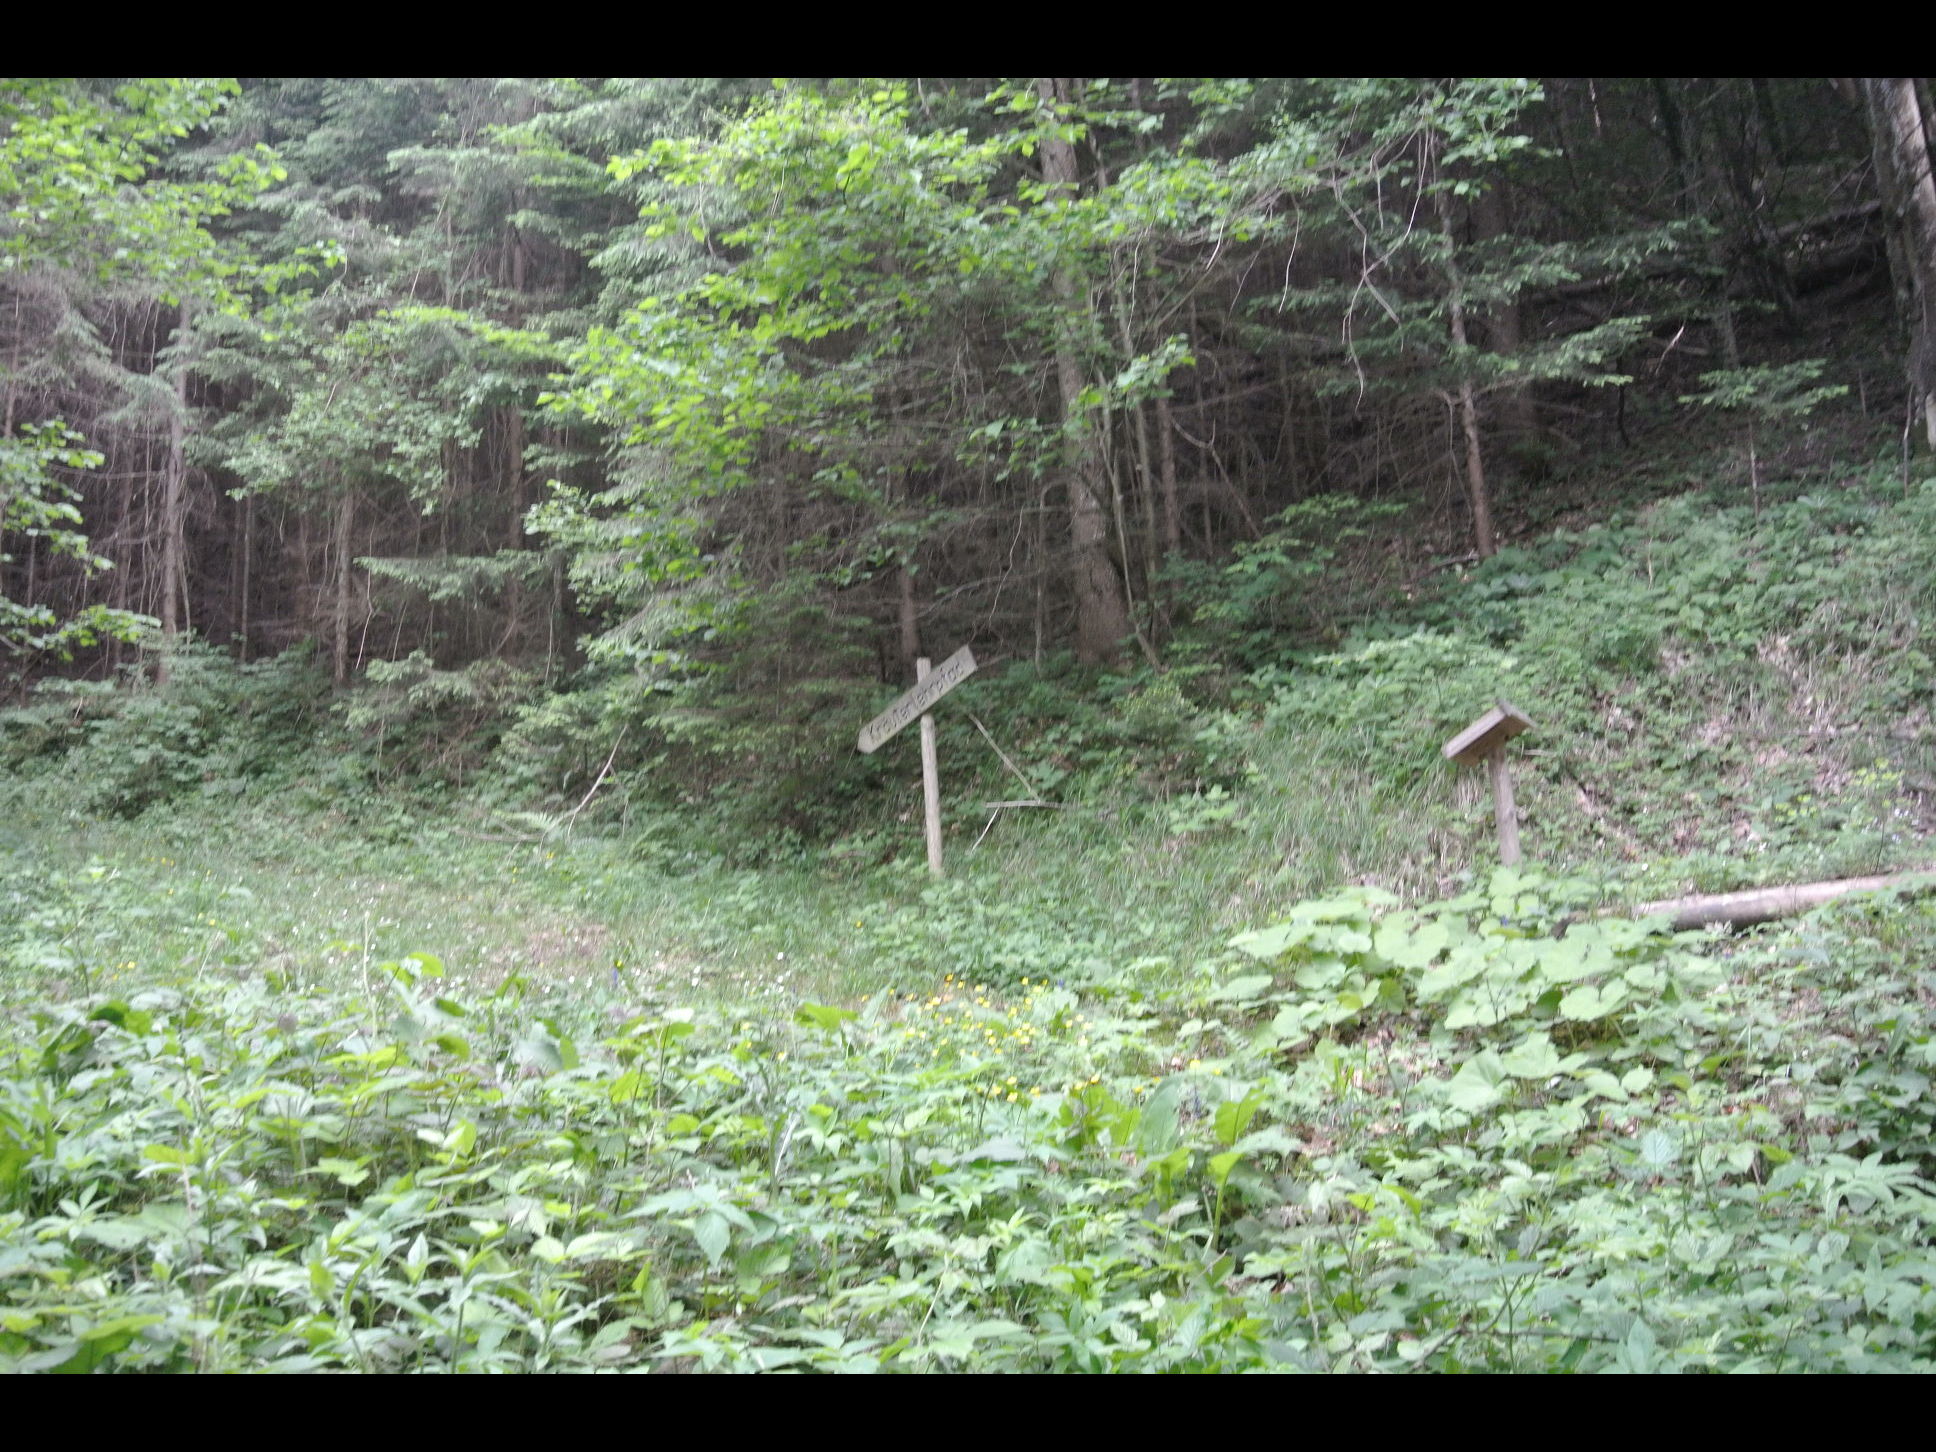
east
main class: Woodland
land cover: Spruce dominated coniferous woodland
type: alpine coniferous forest
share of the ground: > 75 %
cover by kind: coniferous forest trees 100 %
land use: Forestry
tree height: > 5 m
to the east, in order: Spruce dominated coniferous woodland; Tracks; Spruce dominated coniferous woodland; Spruce dominated mixed woodland
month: May
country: AT
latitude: 47.9833
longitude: 15.7504
